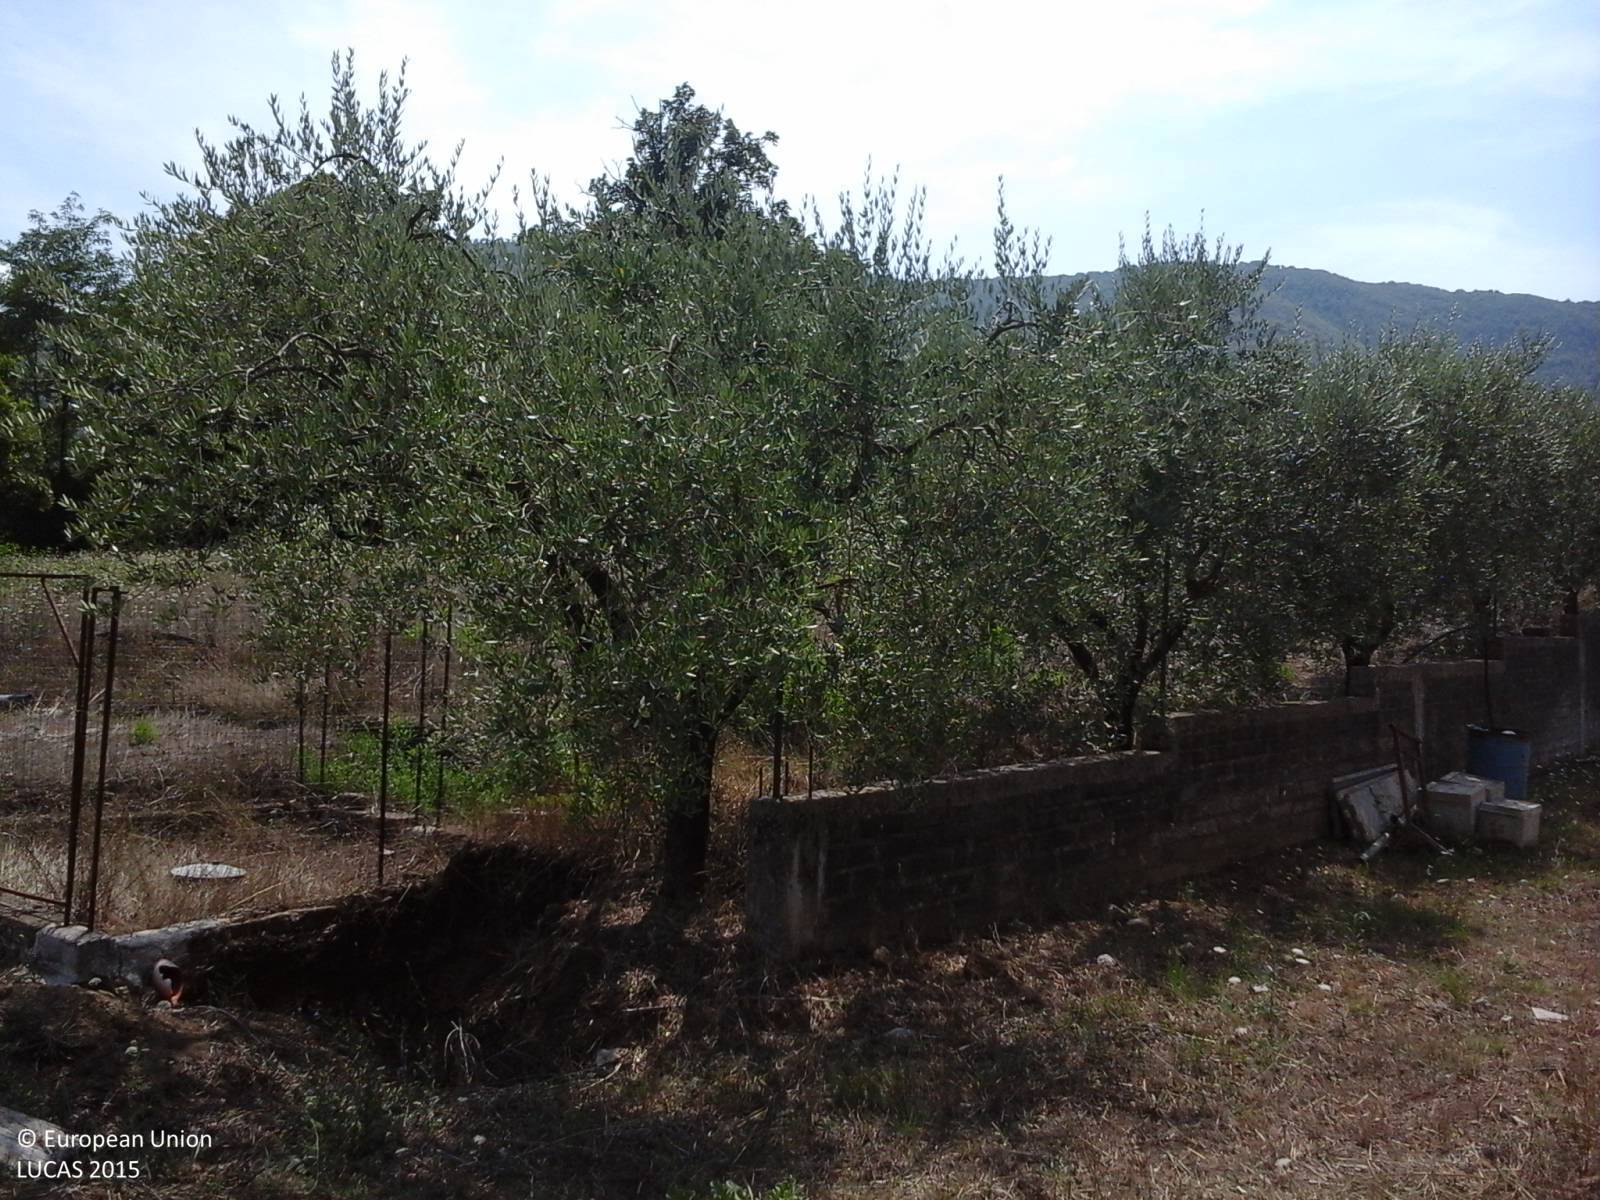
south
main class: Cropland
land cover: Vineyards
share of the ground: > 75 %
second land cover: Spontaneously vegetated surfaces
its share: > 75 %
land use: Agriculture (excluding fallow land and kitchen gardens)
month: August
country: IT
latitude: 41.5307
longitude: 13.3788
